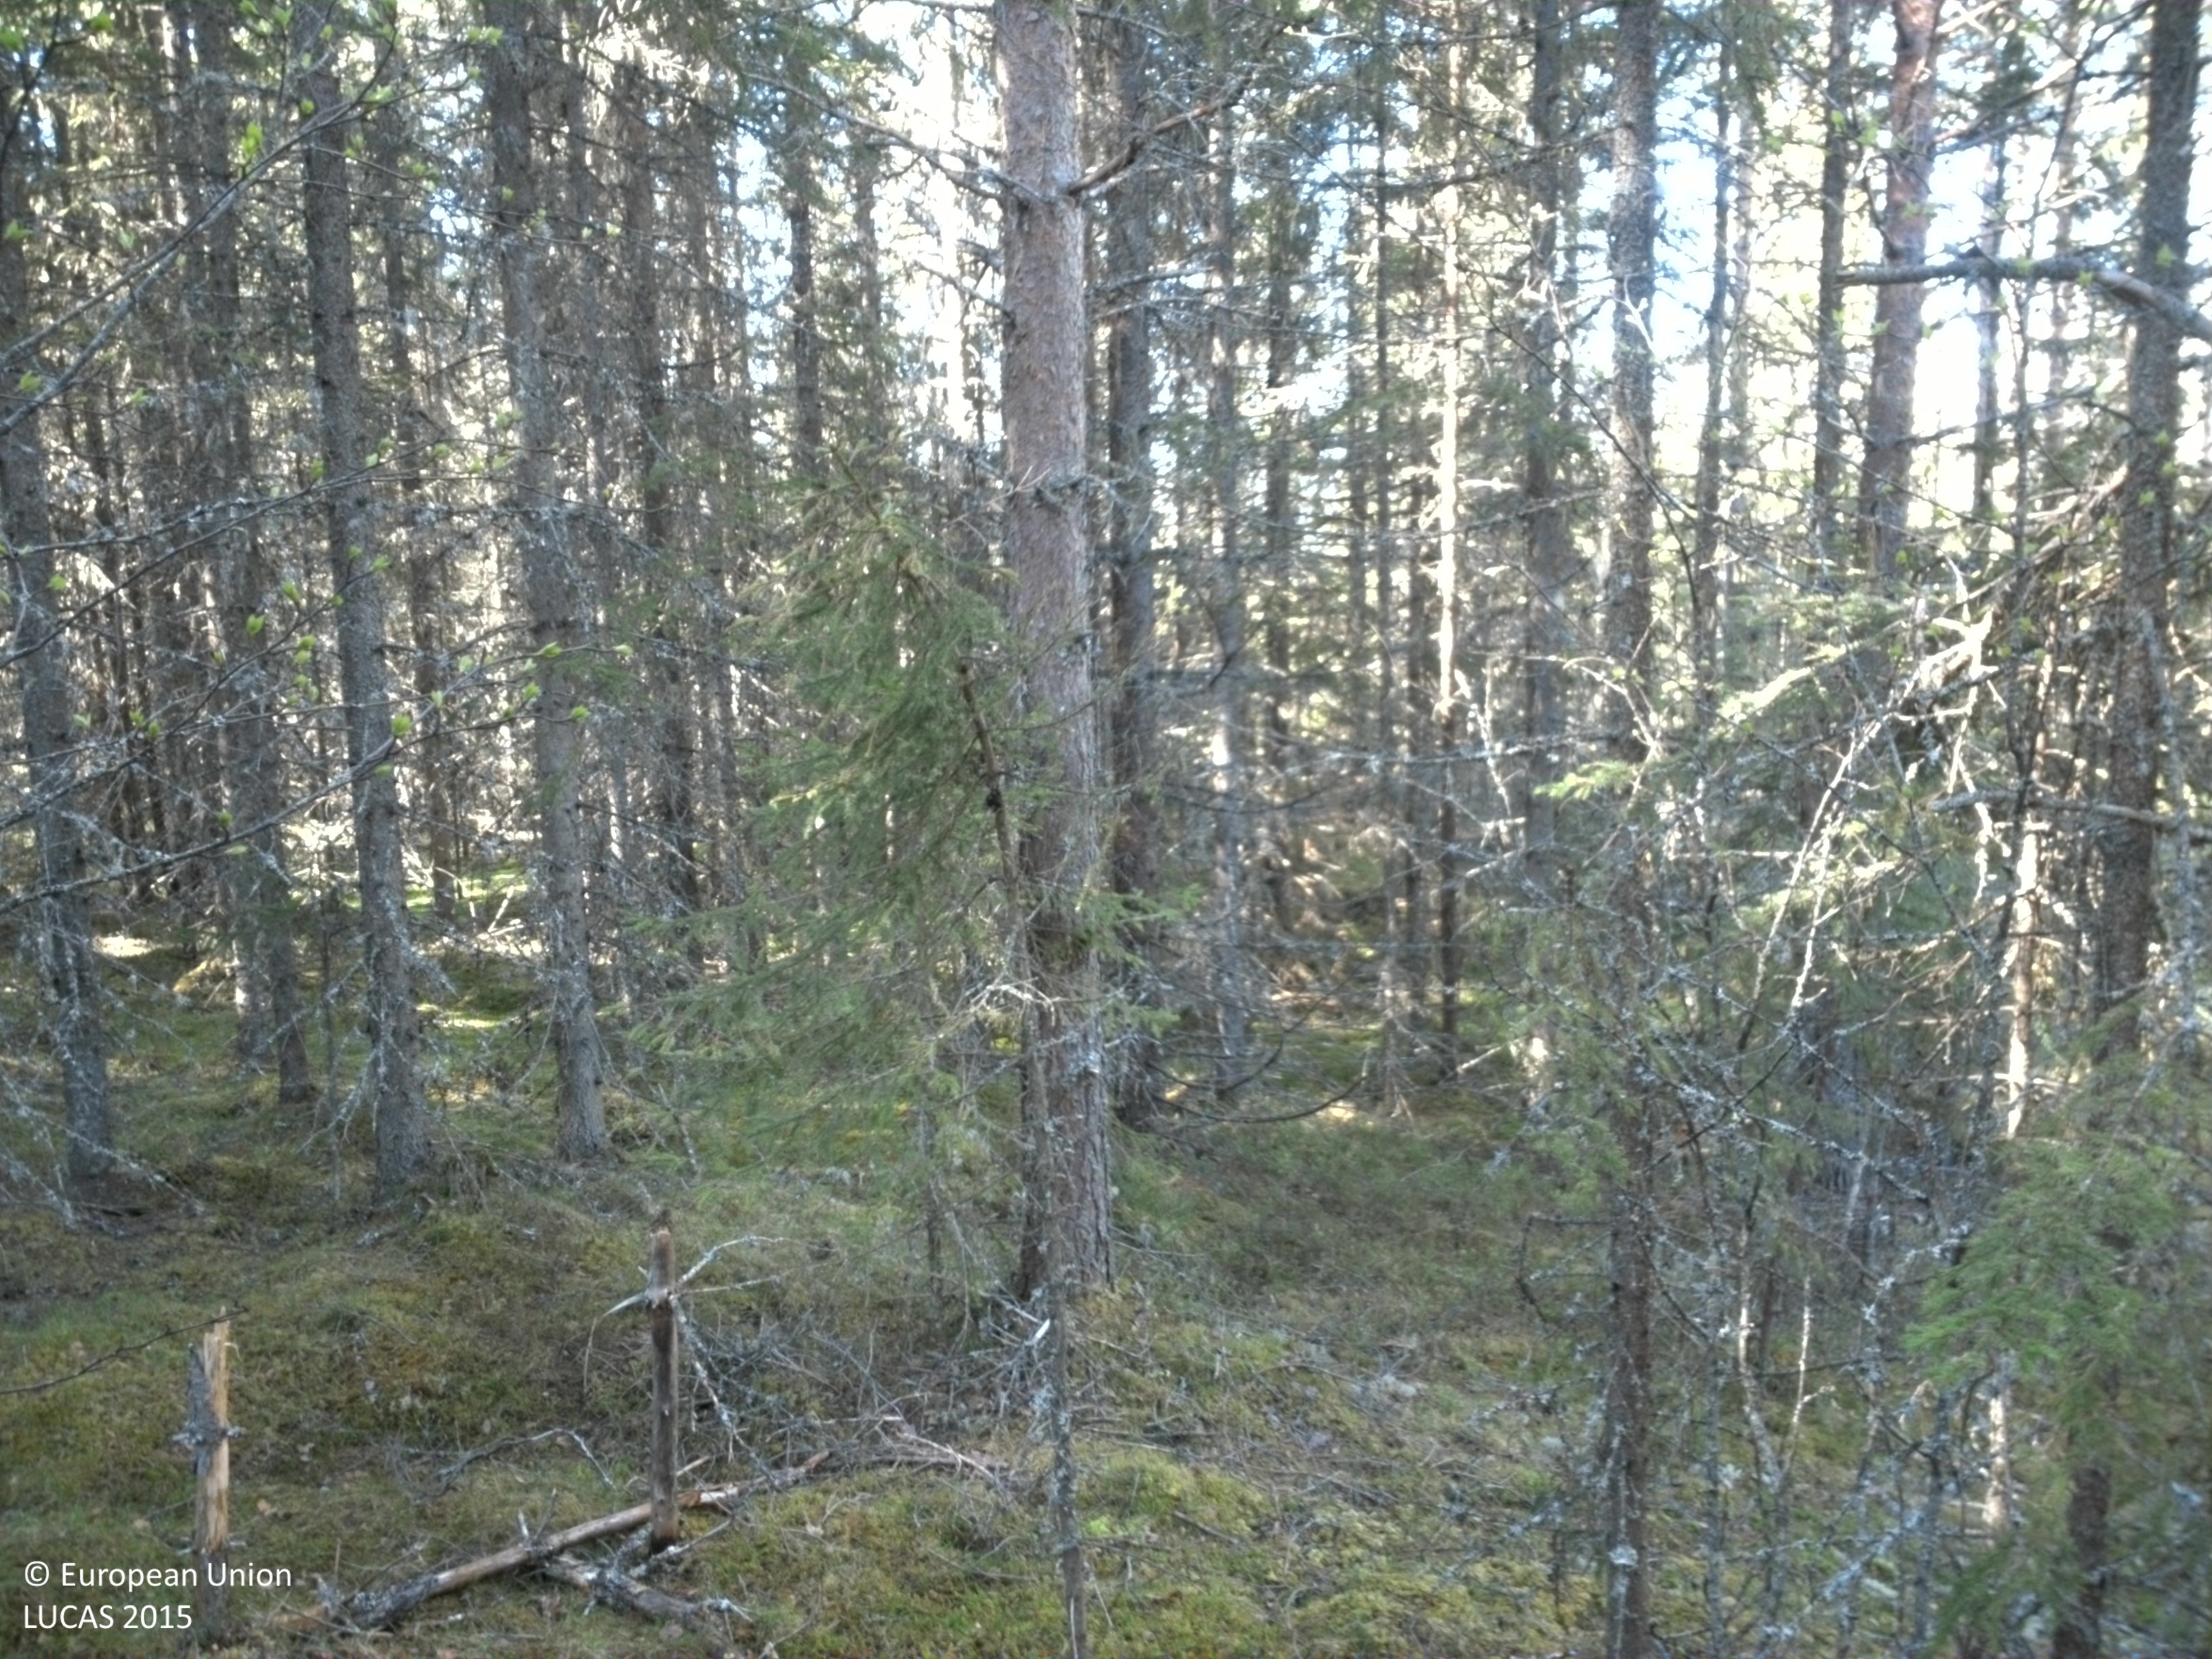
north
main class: Woodland
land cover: Spruce dominated mixed woodland
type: boreal forest
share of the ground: > 75 %
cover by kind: coniferous forest trees 65 %, broadleaved forest trees 25 %, shrubs 10 %
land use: Forestry
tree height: > 5 m
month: May
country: SE
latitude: 60.9706
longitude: 12.4116
